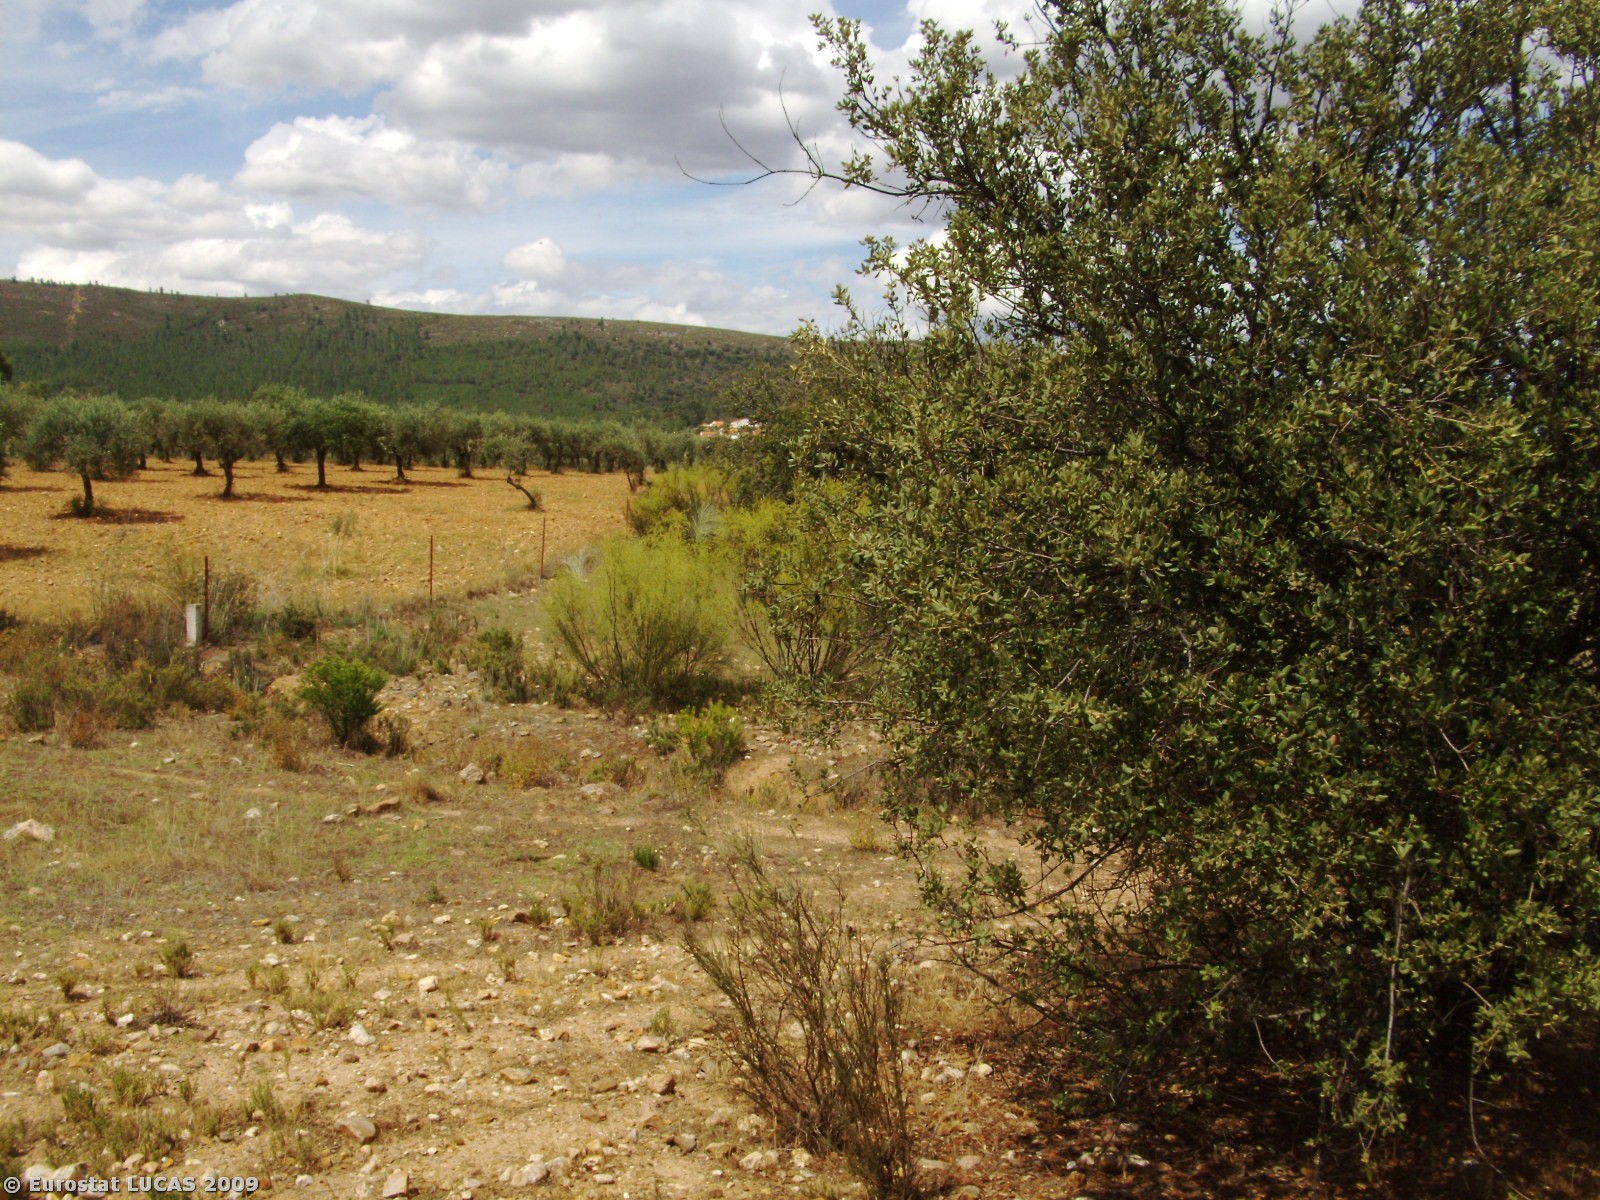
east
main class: Woodland
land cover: Broadleaved woodland
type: broadleaved evergreen forest
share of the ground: 25 - 50 %
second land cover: Spontaneously vegetated surfaces
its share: 10 - 25 %
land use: Forestry
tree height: > 5 m
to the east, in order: Broadleaved woodland; Spontaneously vegetated surfaces; Broadleaved woodland; Spontaneously vegetated surfaces; Rivers and streams; Spontaneously vegetated surfaces; Olive groves; Paved roads, cycling and walking lanes; Olive groves
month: June
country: PT
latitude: 39.9886
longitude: -6.8936
